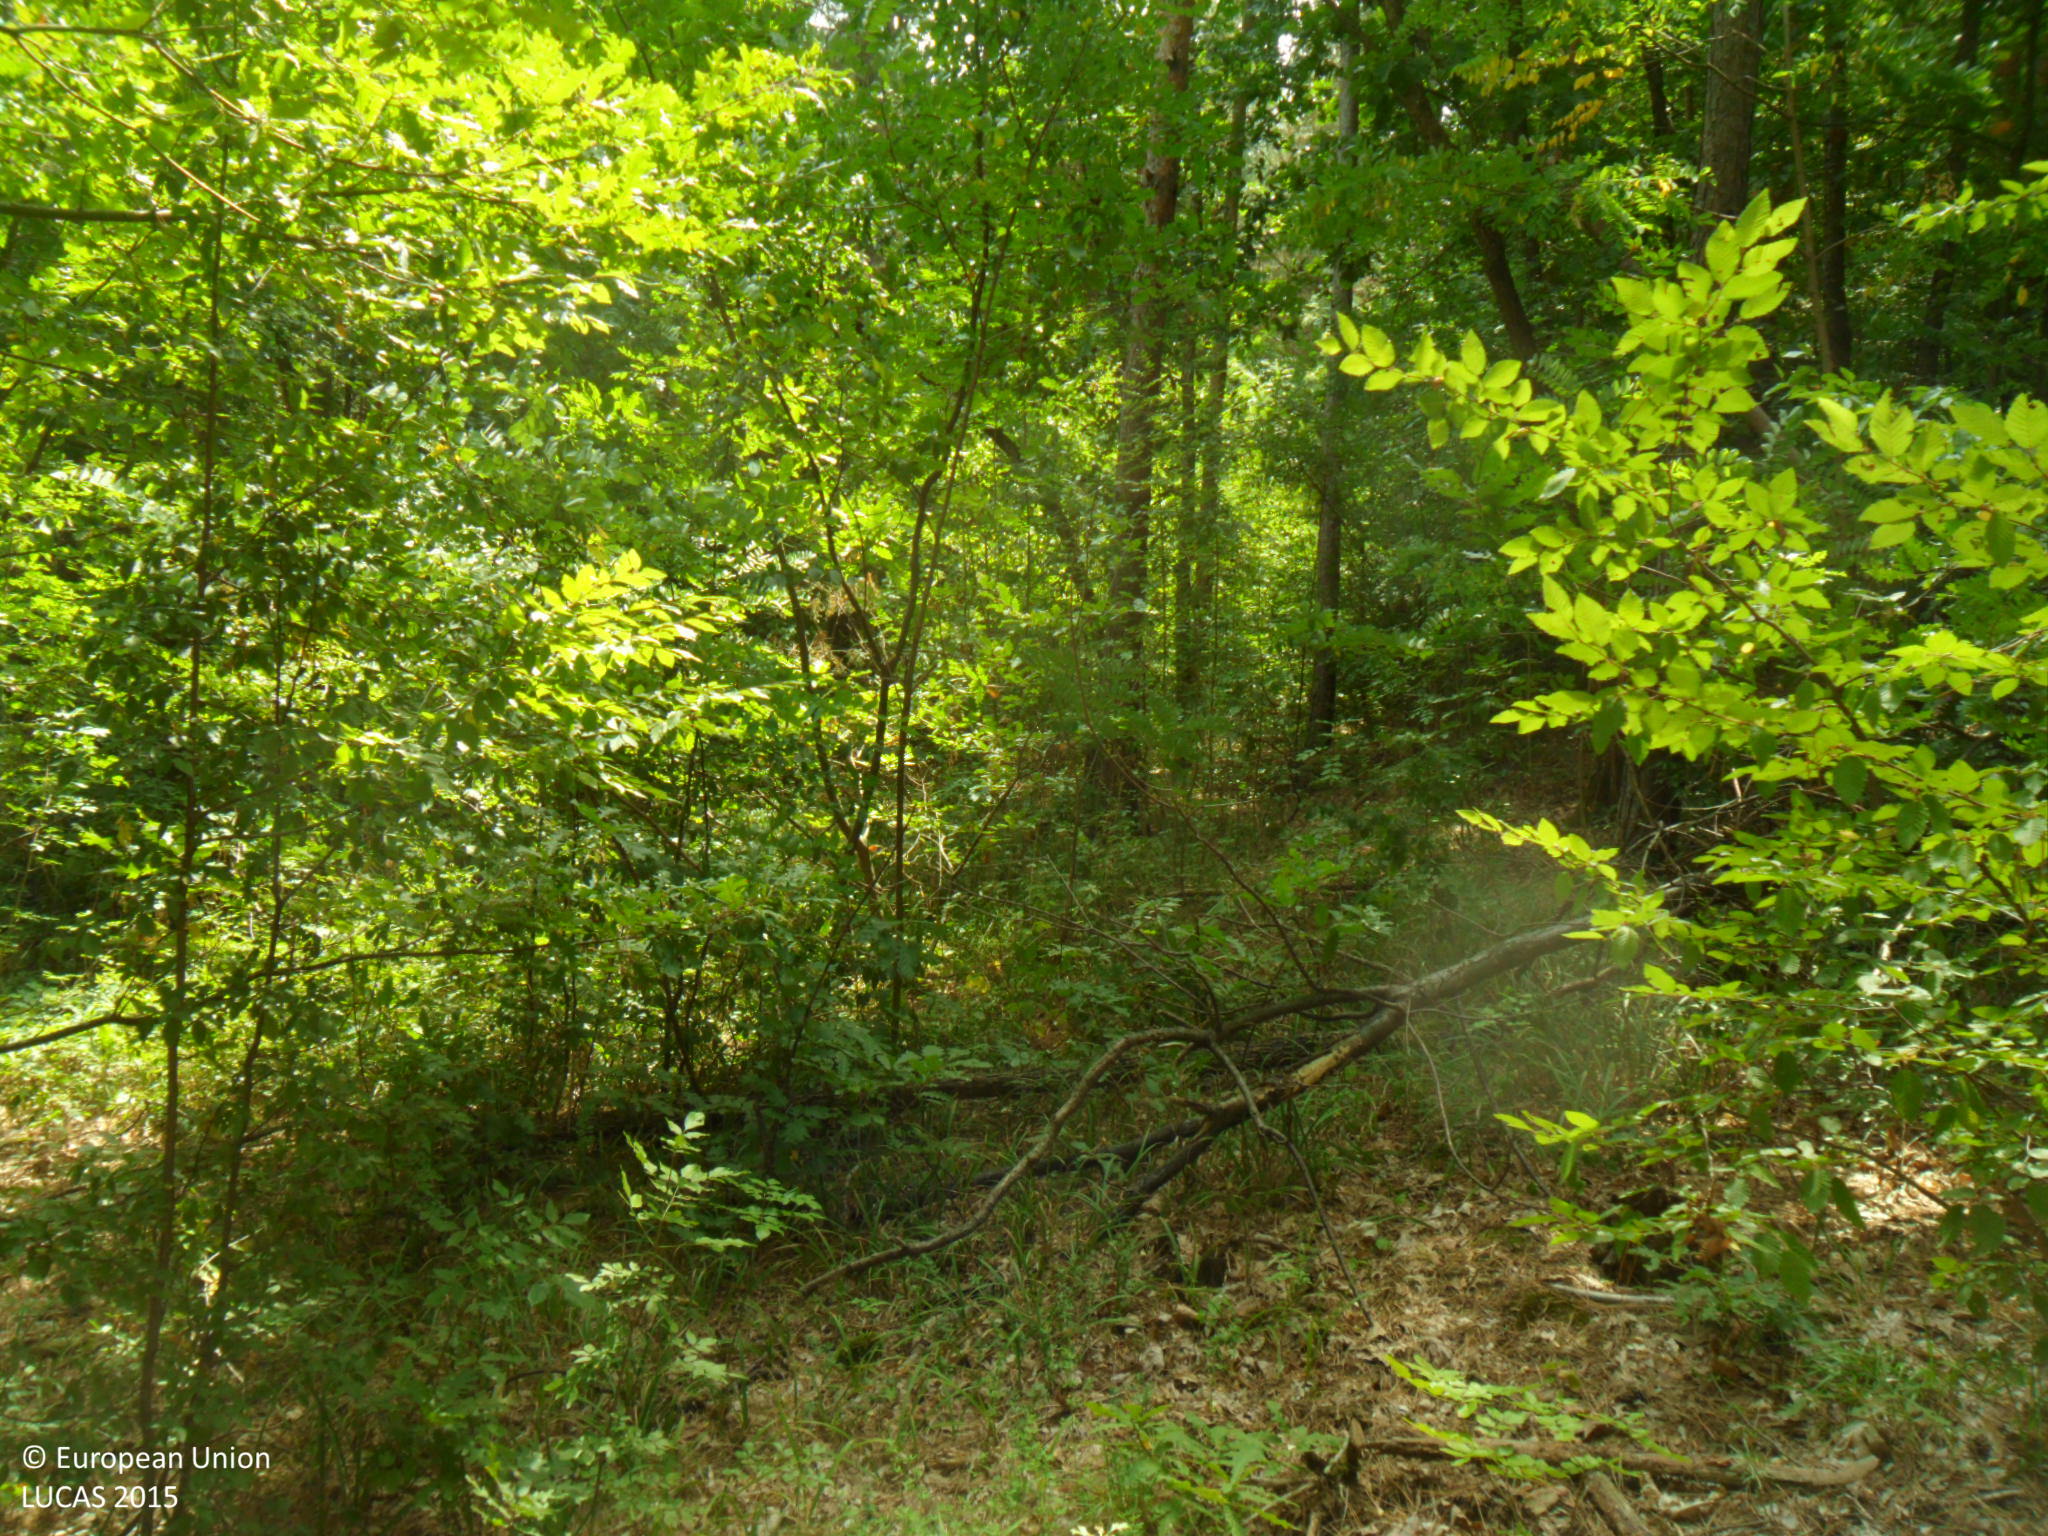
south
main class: Woodland
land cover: Pine dominated mixed woodland
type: hemiboreal forest and nemoral coniferous forest and mixed broadleaved-coniferous forest
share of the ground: > 75 %
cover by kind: coniferous forest trees 50 %, broadleaved forest trees 50 %
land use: Forestry
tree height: > 5 m
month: August
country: BG
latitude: 42.9742
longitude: 26.7684
